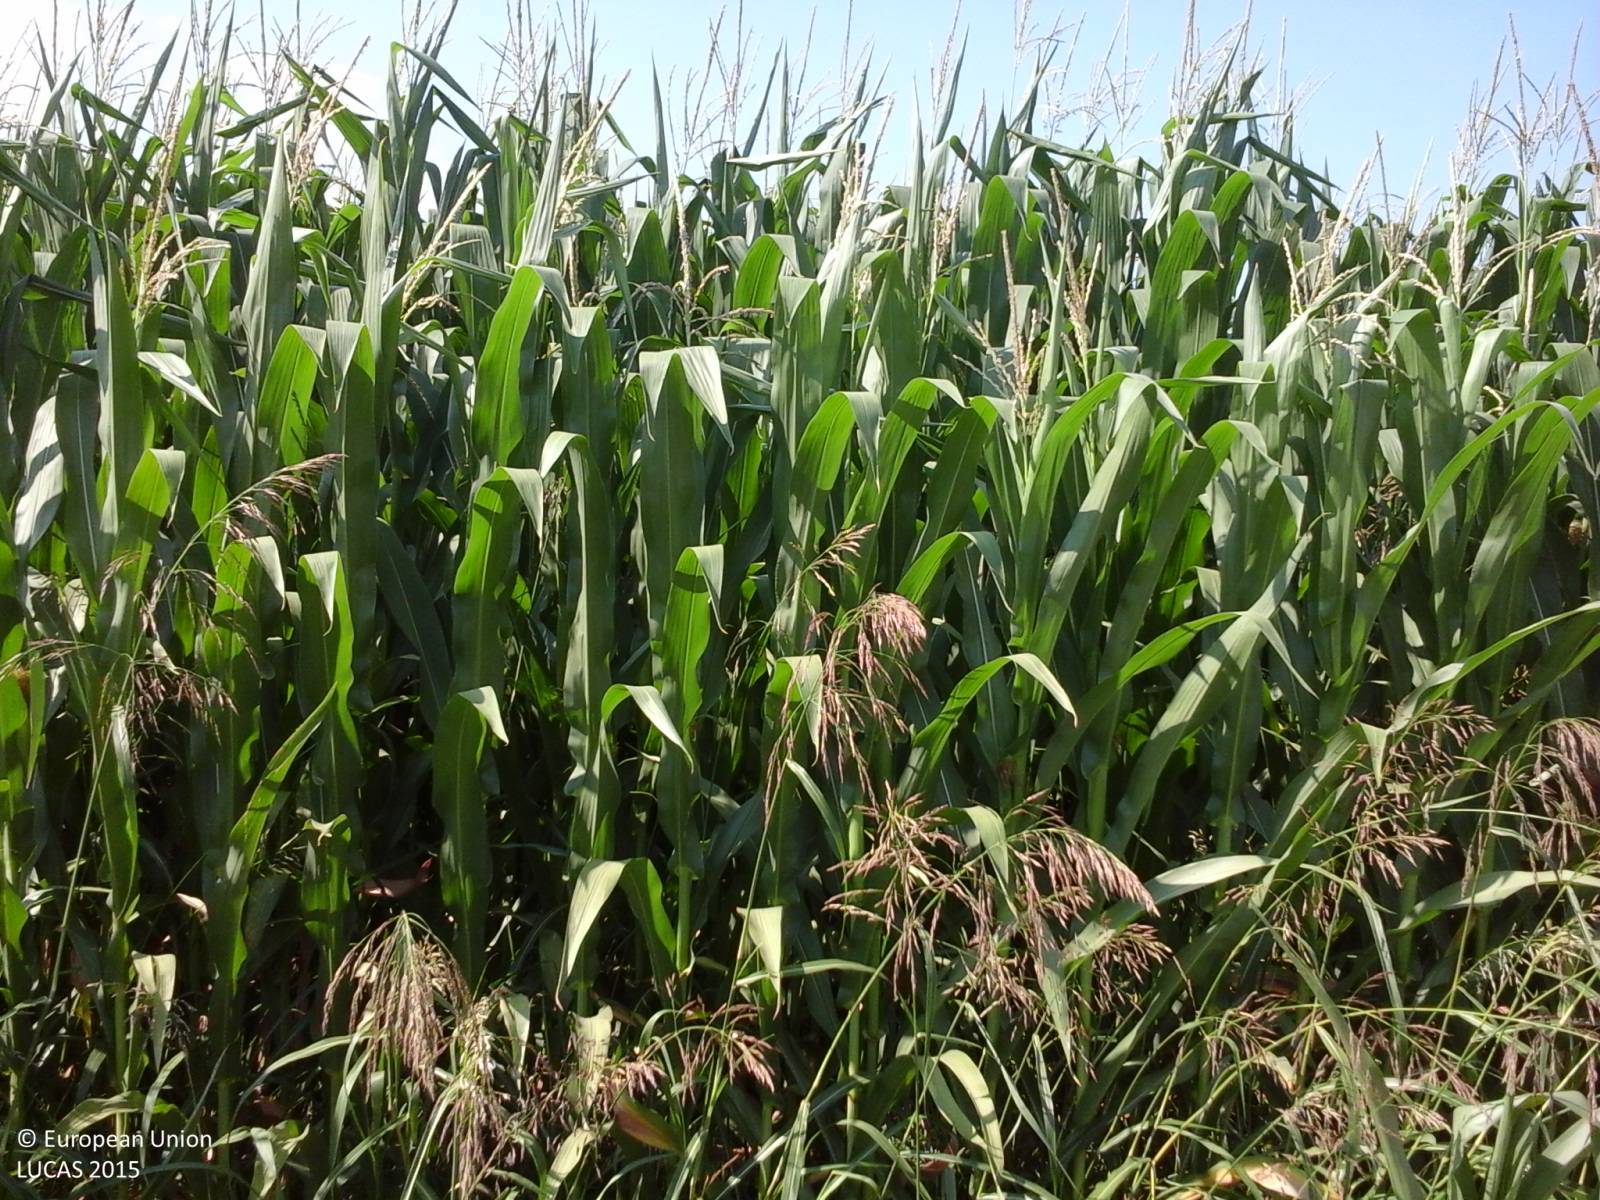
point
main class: Cropland
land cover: Maize
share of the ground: > 75 %
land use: Agriculture (excluding fallow land and kitchen gardens)
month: July
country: IT
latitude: 41.0316
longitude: 14.1343
